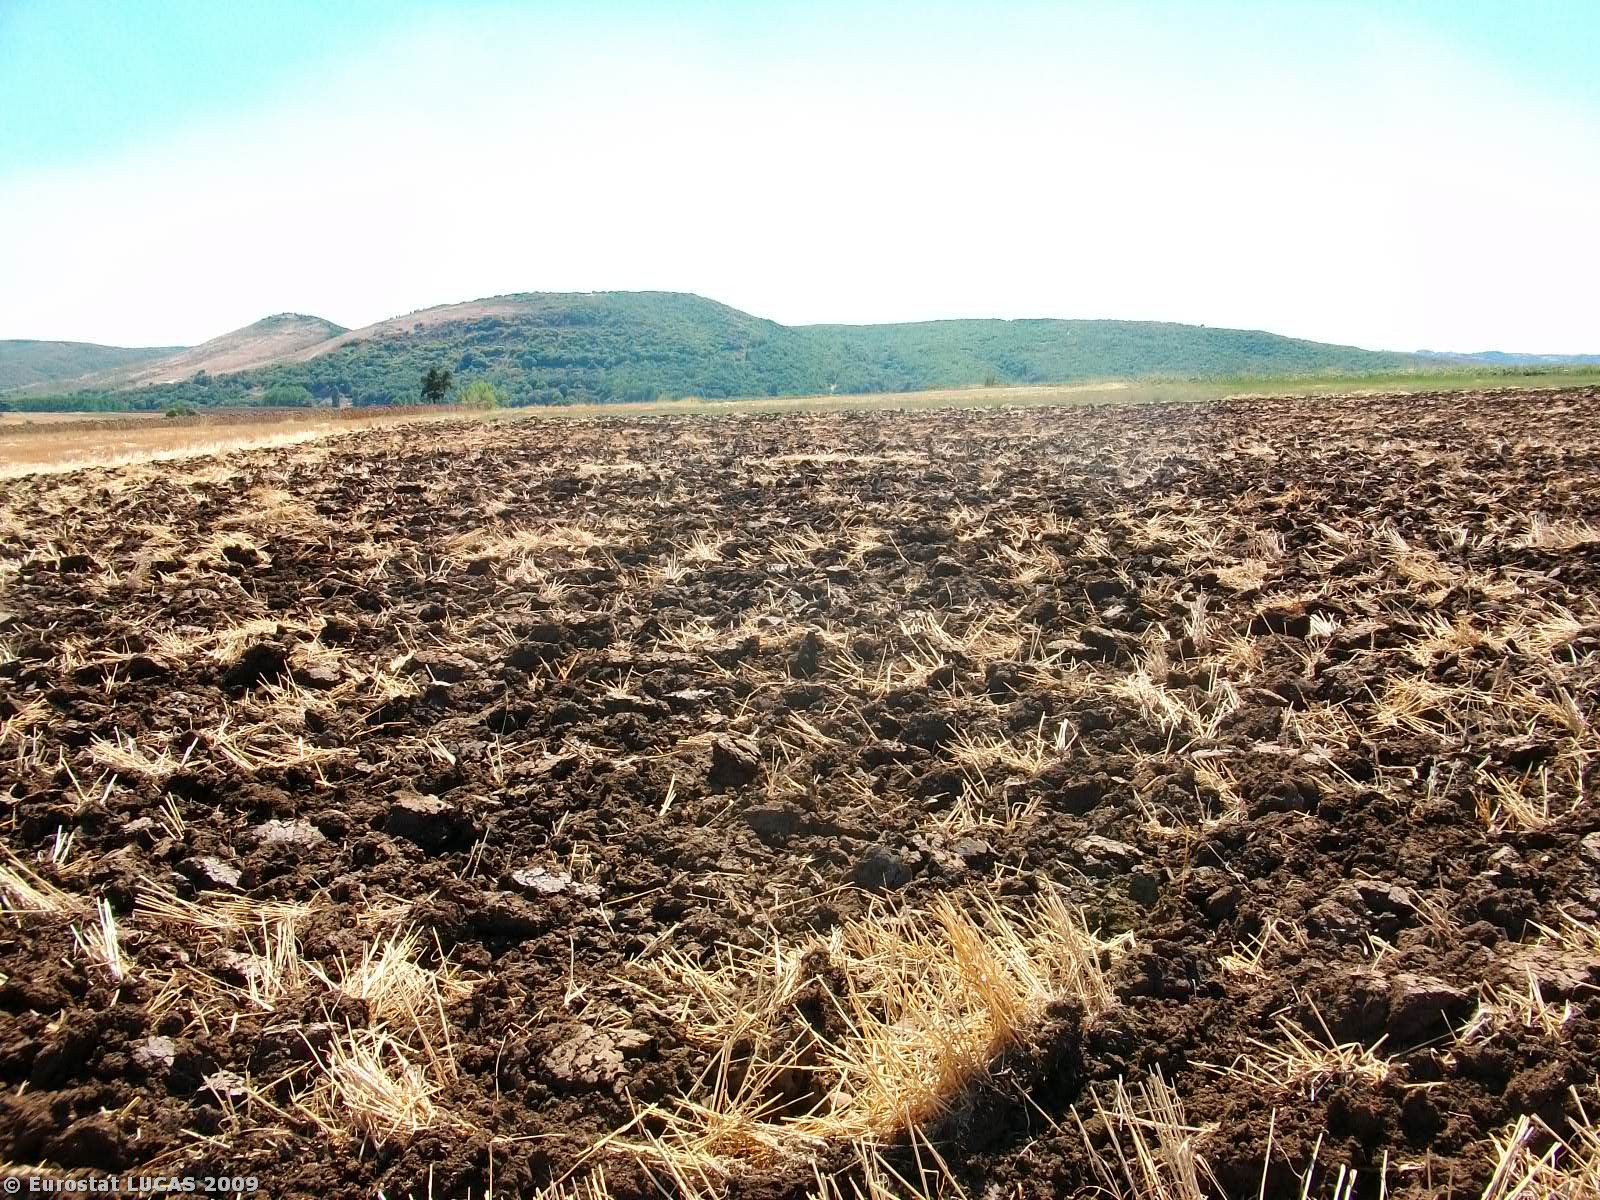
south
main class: Cropland
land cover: Common wheat
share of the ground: < 10 %
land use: Agriculture (excluding fallow land and kitchen gardens)
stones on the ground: < 10 %
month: August
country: GR
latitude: 41.3924
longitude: 26.3266
